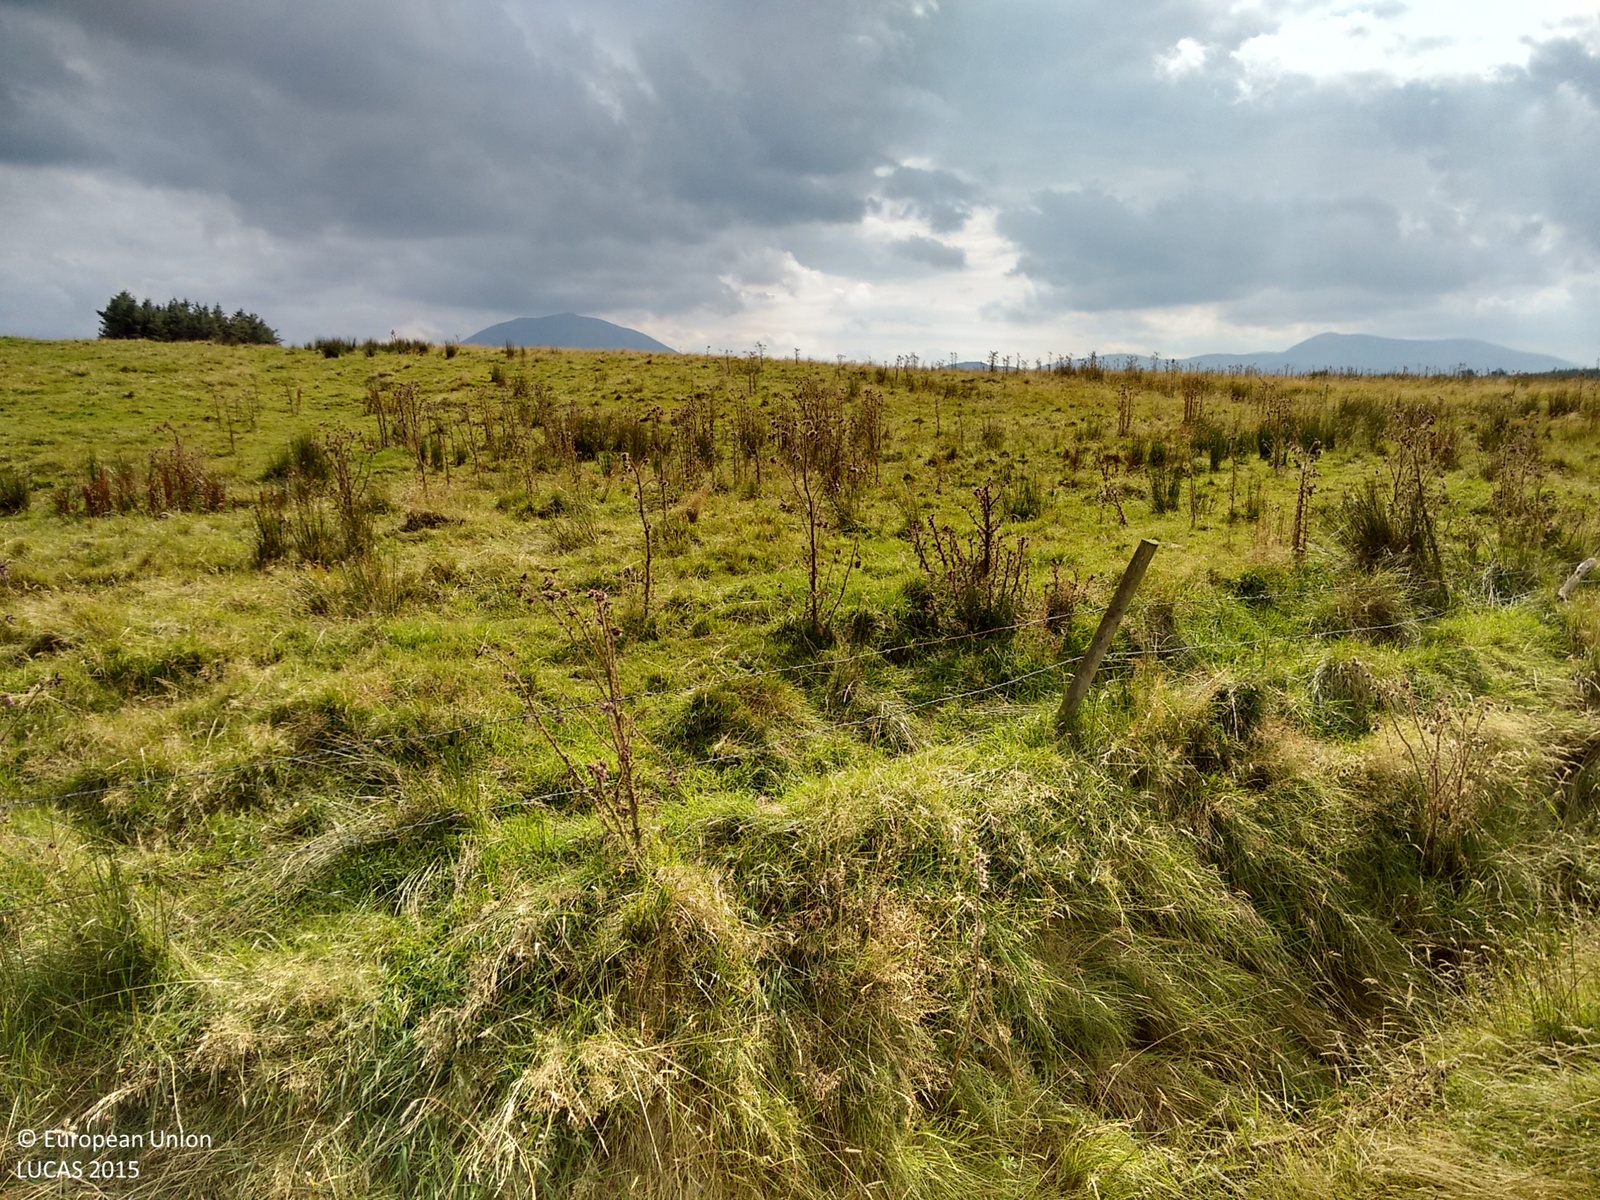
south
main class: Grassland
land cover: Grassland without tree/shrub cover
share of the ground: > 75 %
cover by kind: herbaceous plants 100 %
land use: Agriculture (excluding fallow land and kitchen gardens)
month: September
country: IE
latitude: 54.1097
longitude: -9.3929
